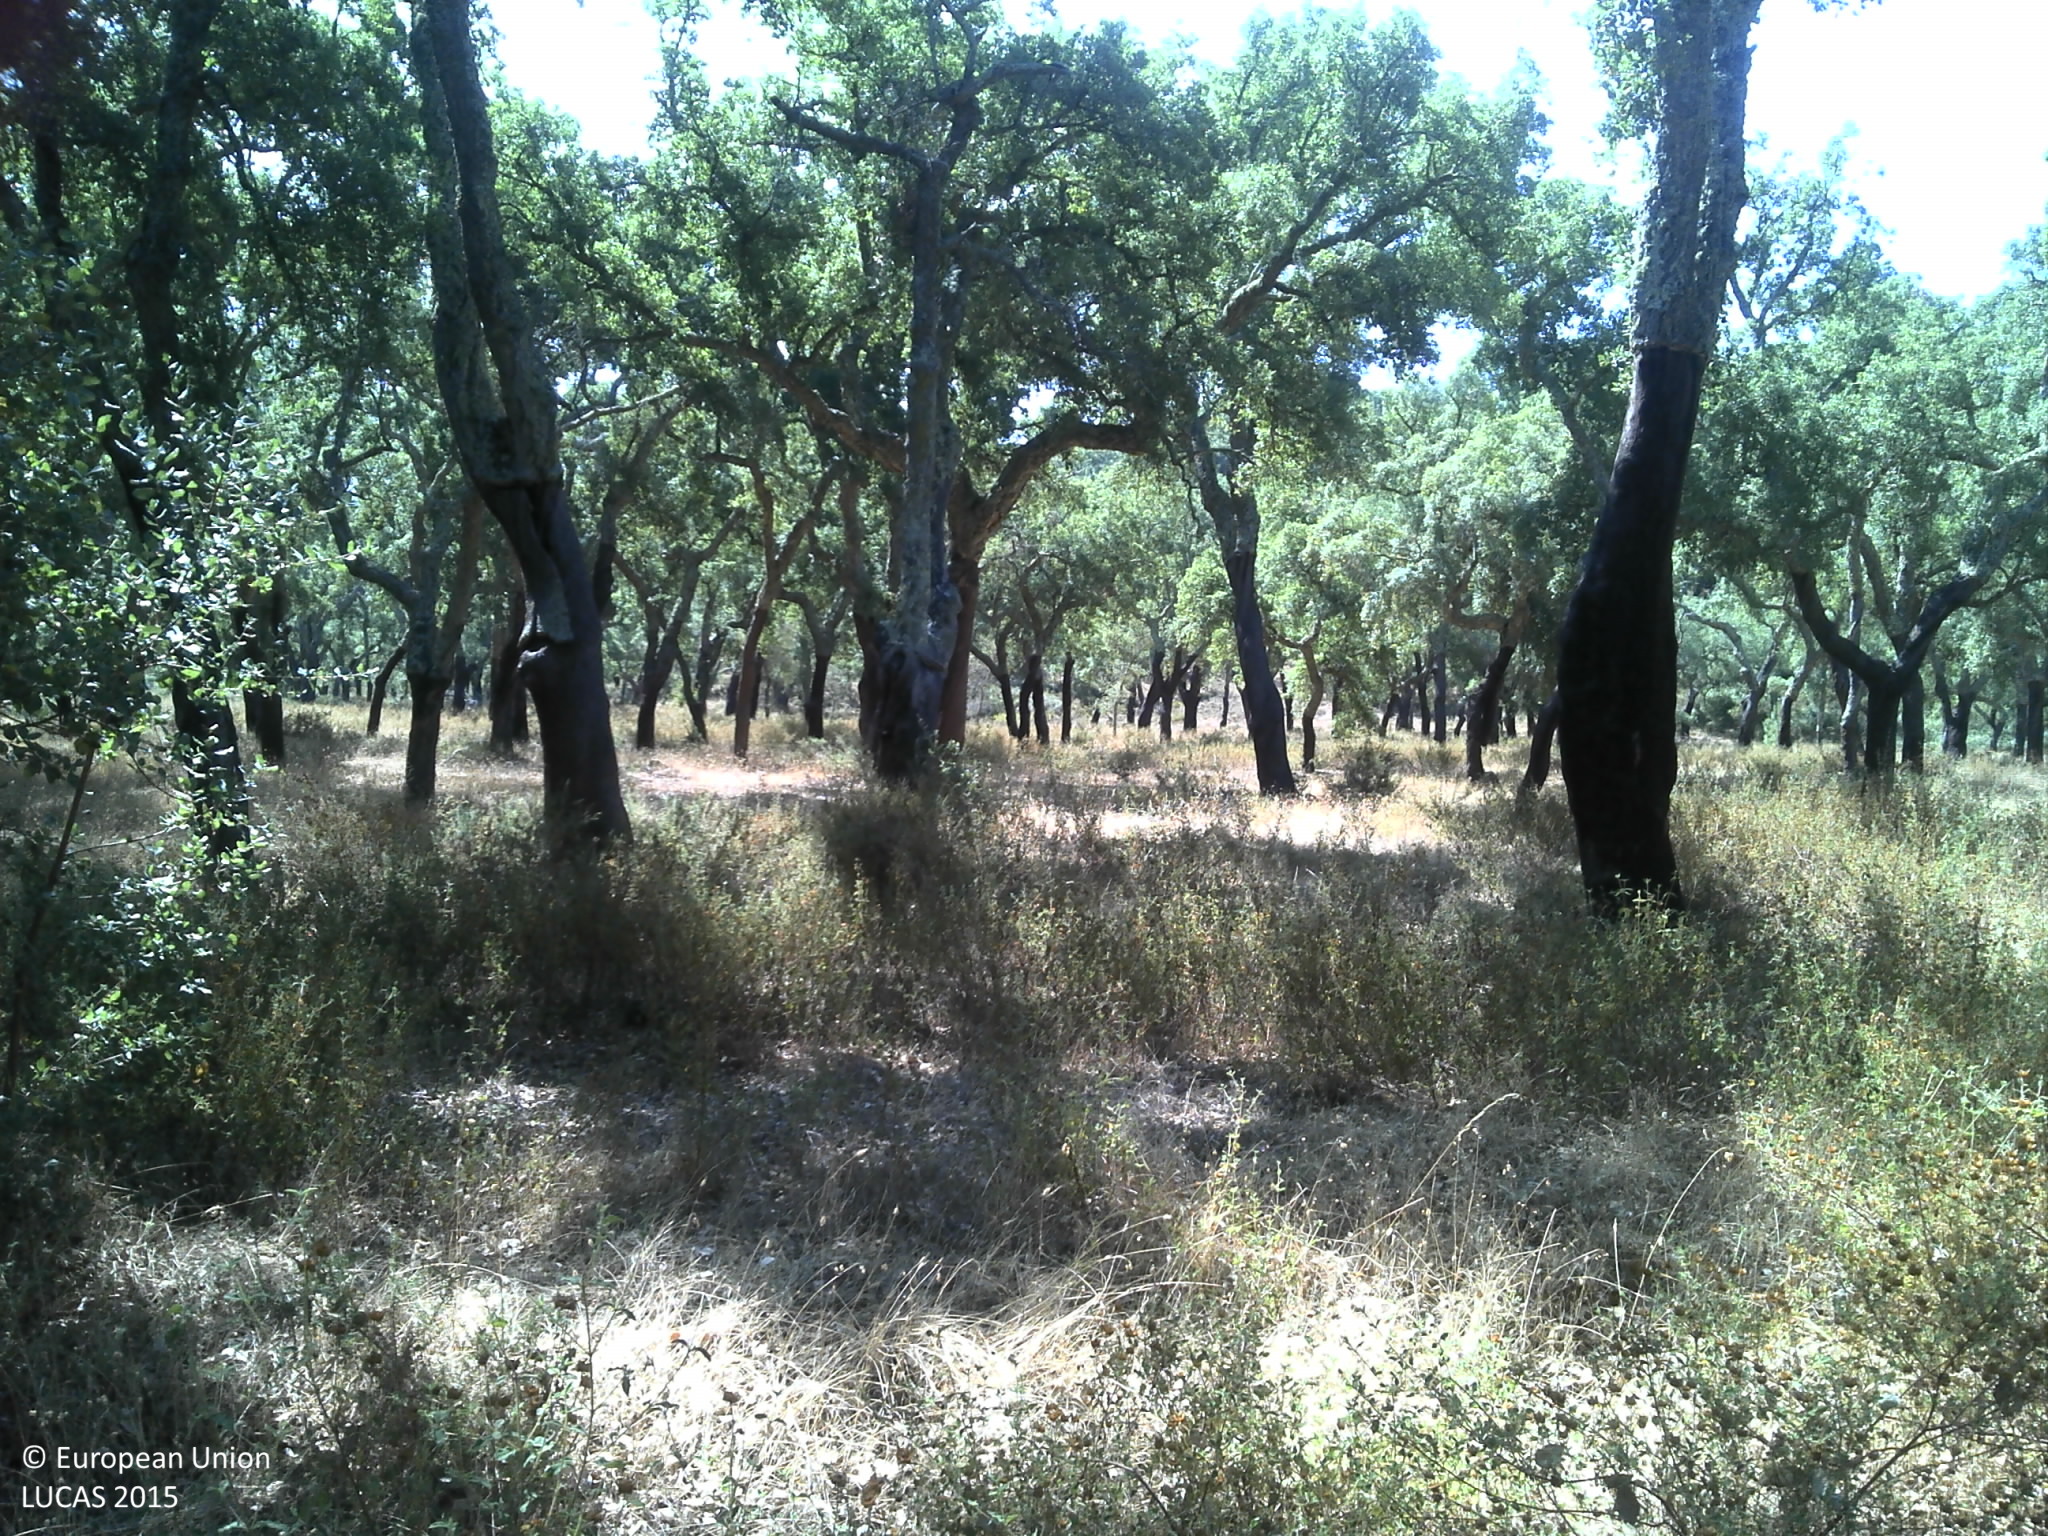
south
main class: Woodland
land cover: Broadleaved woodland
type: broadleaved evergreen forest
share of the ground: 50 - 75 %
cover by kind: broadleaved forest trees 70 %, unconsolidated bare surface 15 %, herbaceous plants 10 %, shrubs 5 %
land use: Forestry
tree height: > 5 m
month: July
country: PT
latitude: 39.2438
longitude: -8.2400
